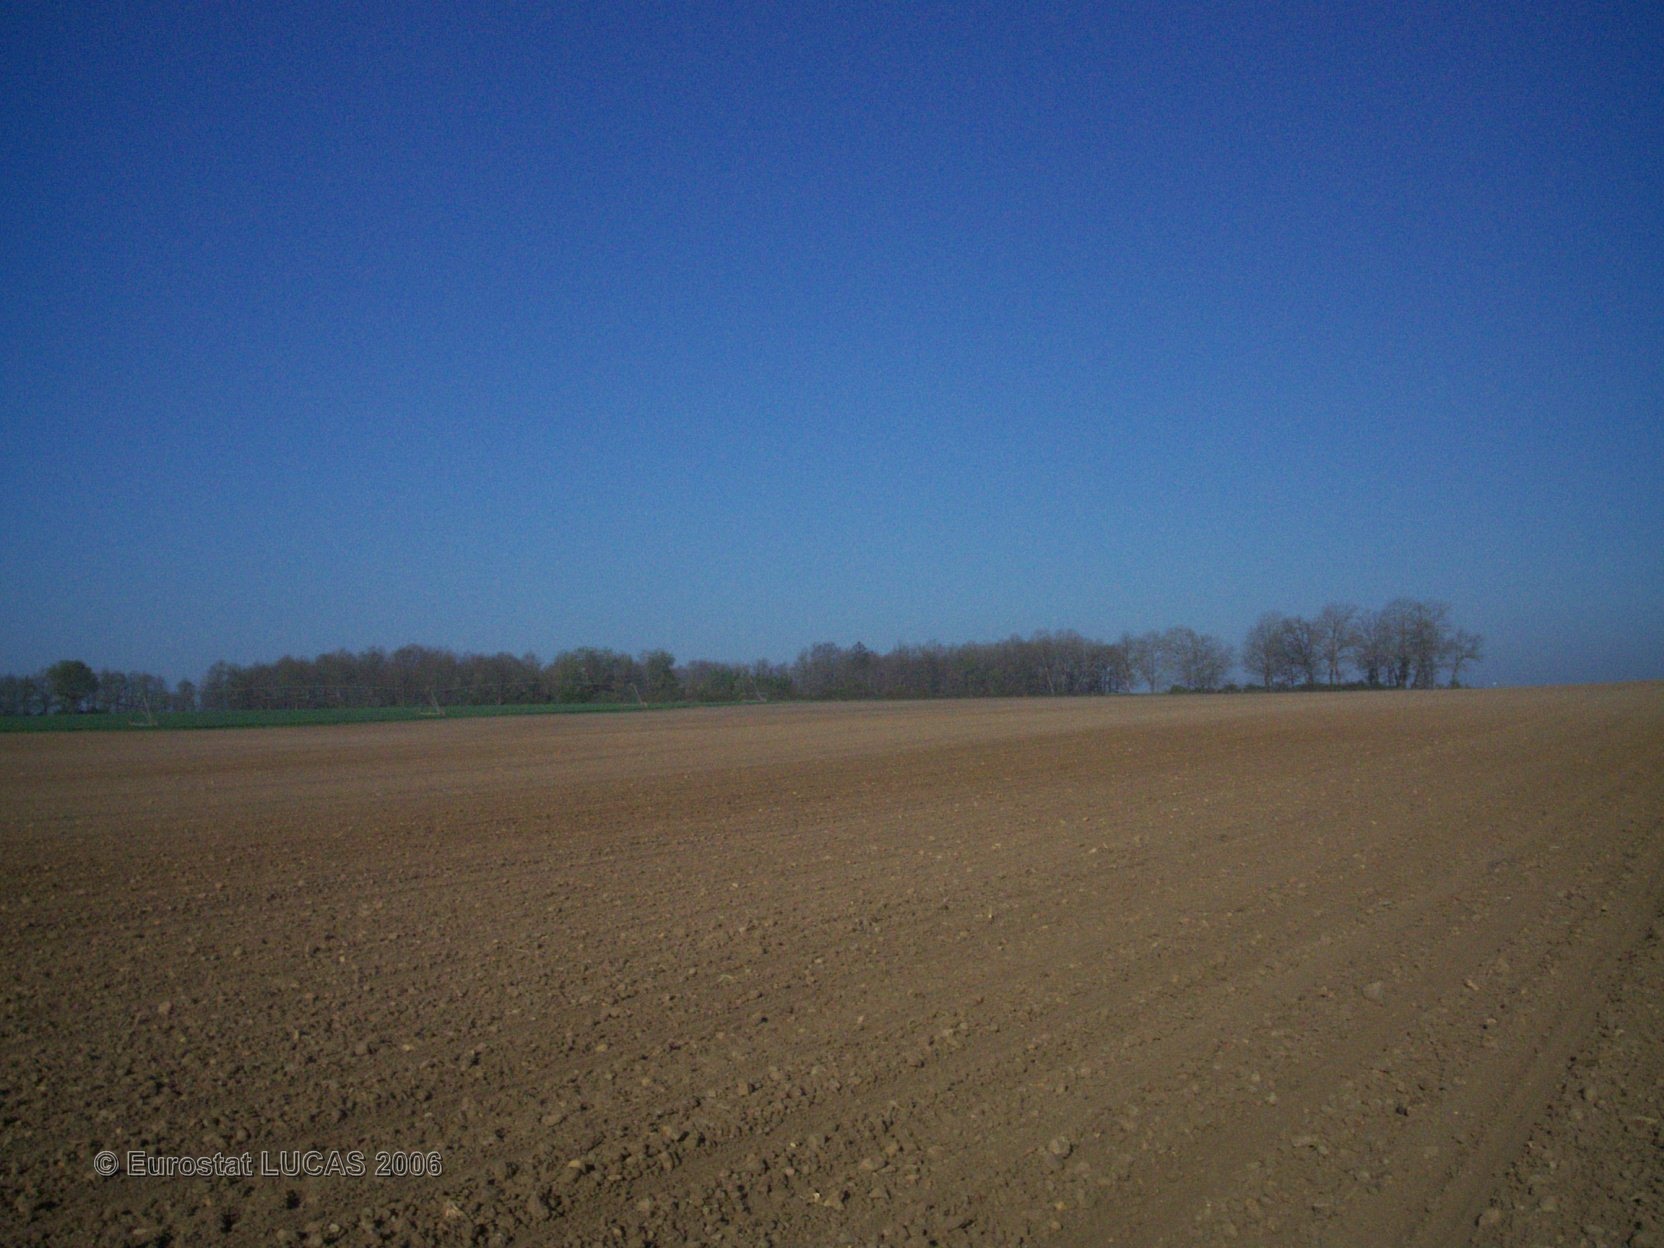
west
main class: Cropland
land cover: Maize
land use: Agriculture (excluding fallow land and kitchen gardens)
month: April
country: FR
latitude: 46.3564
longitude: 0.4305
